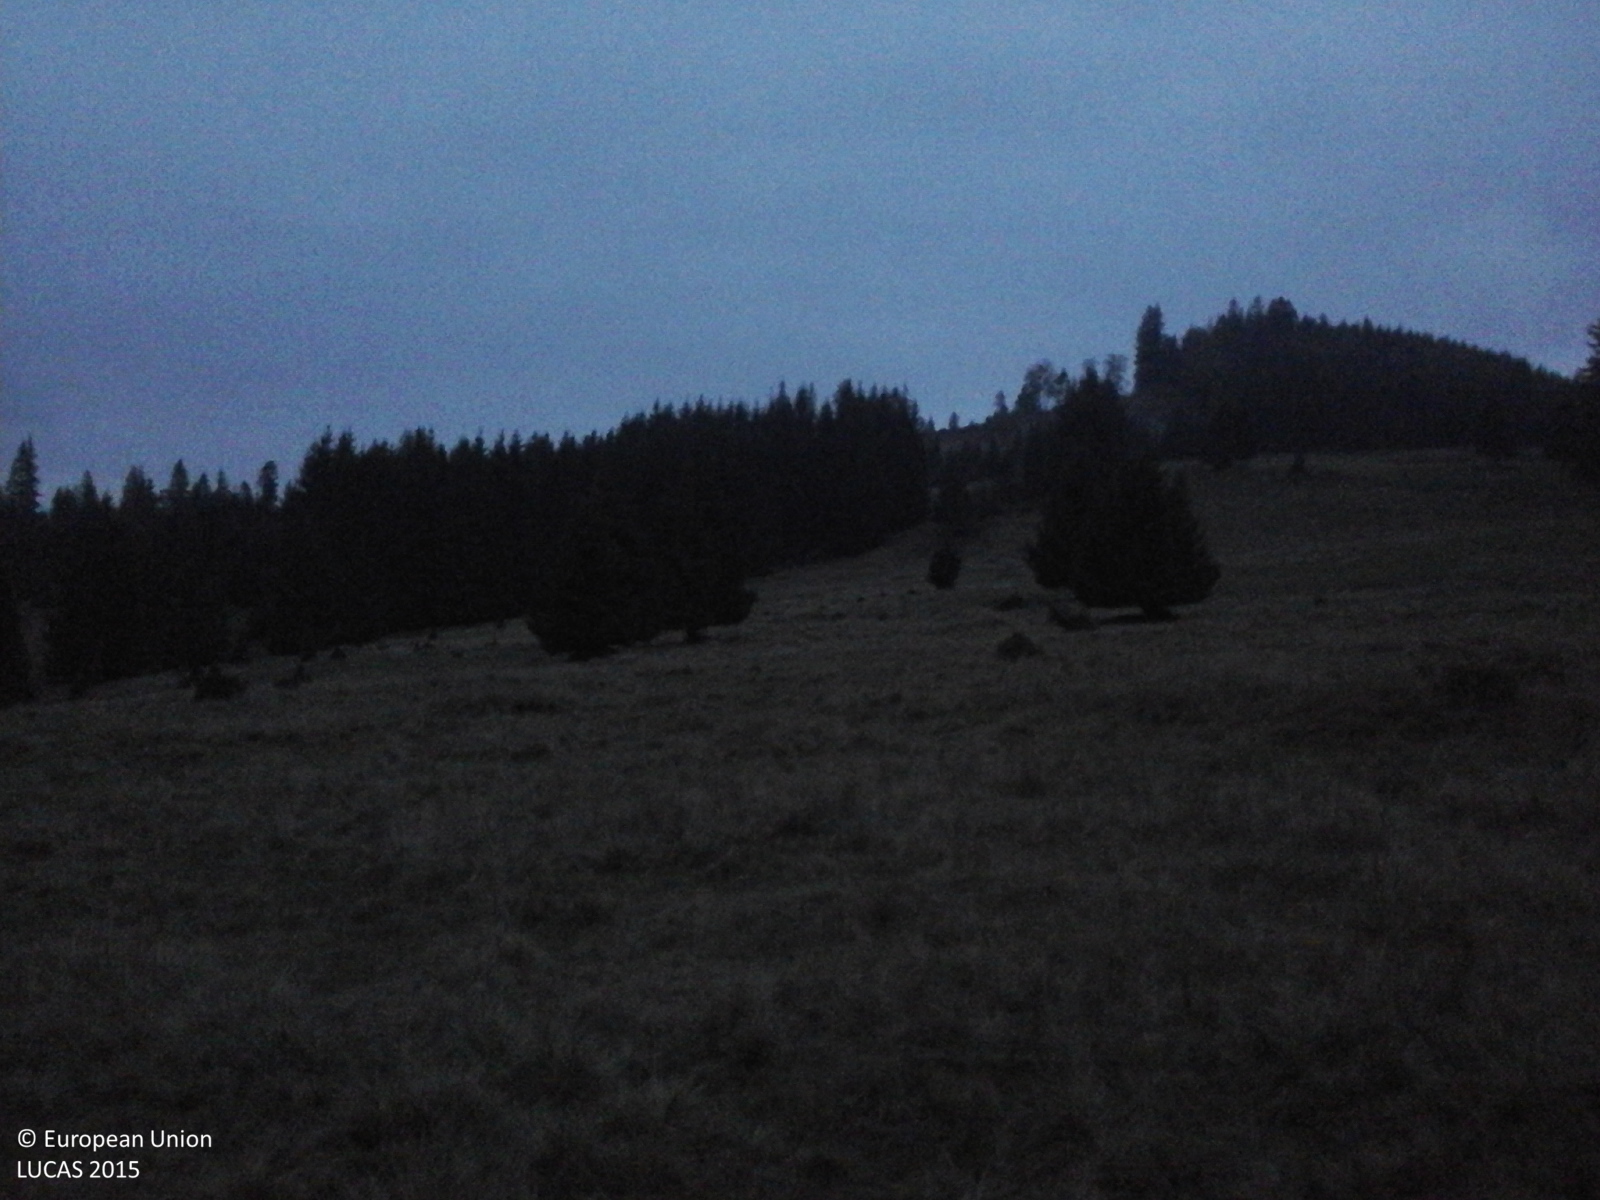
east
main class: Grassland
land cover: Grassland with sparse tree/shrub cover
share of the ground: > 75 %
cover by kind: herbaceous plants 85 %, shrubs 10 %, coniferous forest trees 5 %
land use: Agriculture (excluding fallow land and kitchen gardens)
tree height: > 5 m
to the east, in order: Grassland with sparse tree/shrub cover; Tracks; Grassland with sparse tree/shrub cover; Tracks; Grassland with sparse tree/shrub cover; Spruce dominated coniferous woodland
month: October
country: RO
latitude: 46.3569
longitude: 25.6949
